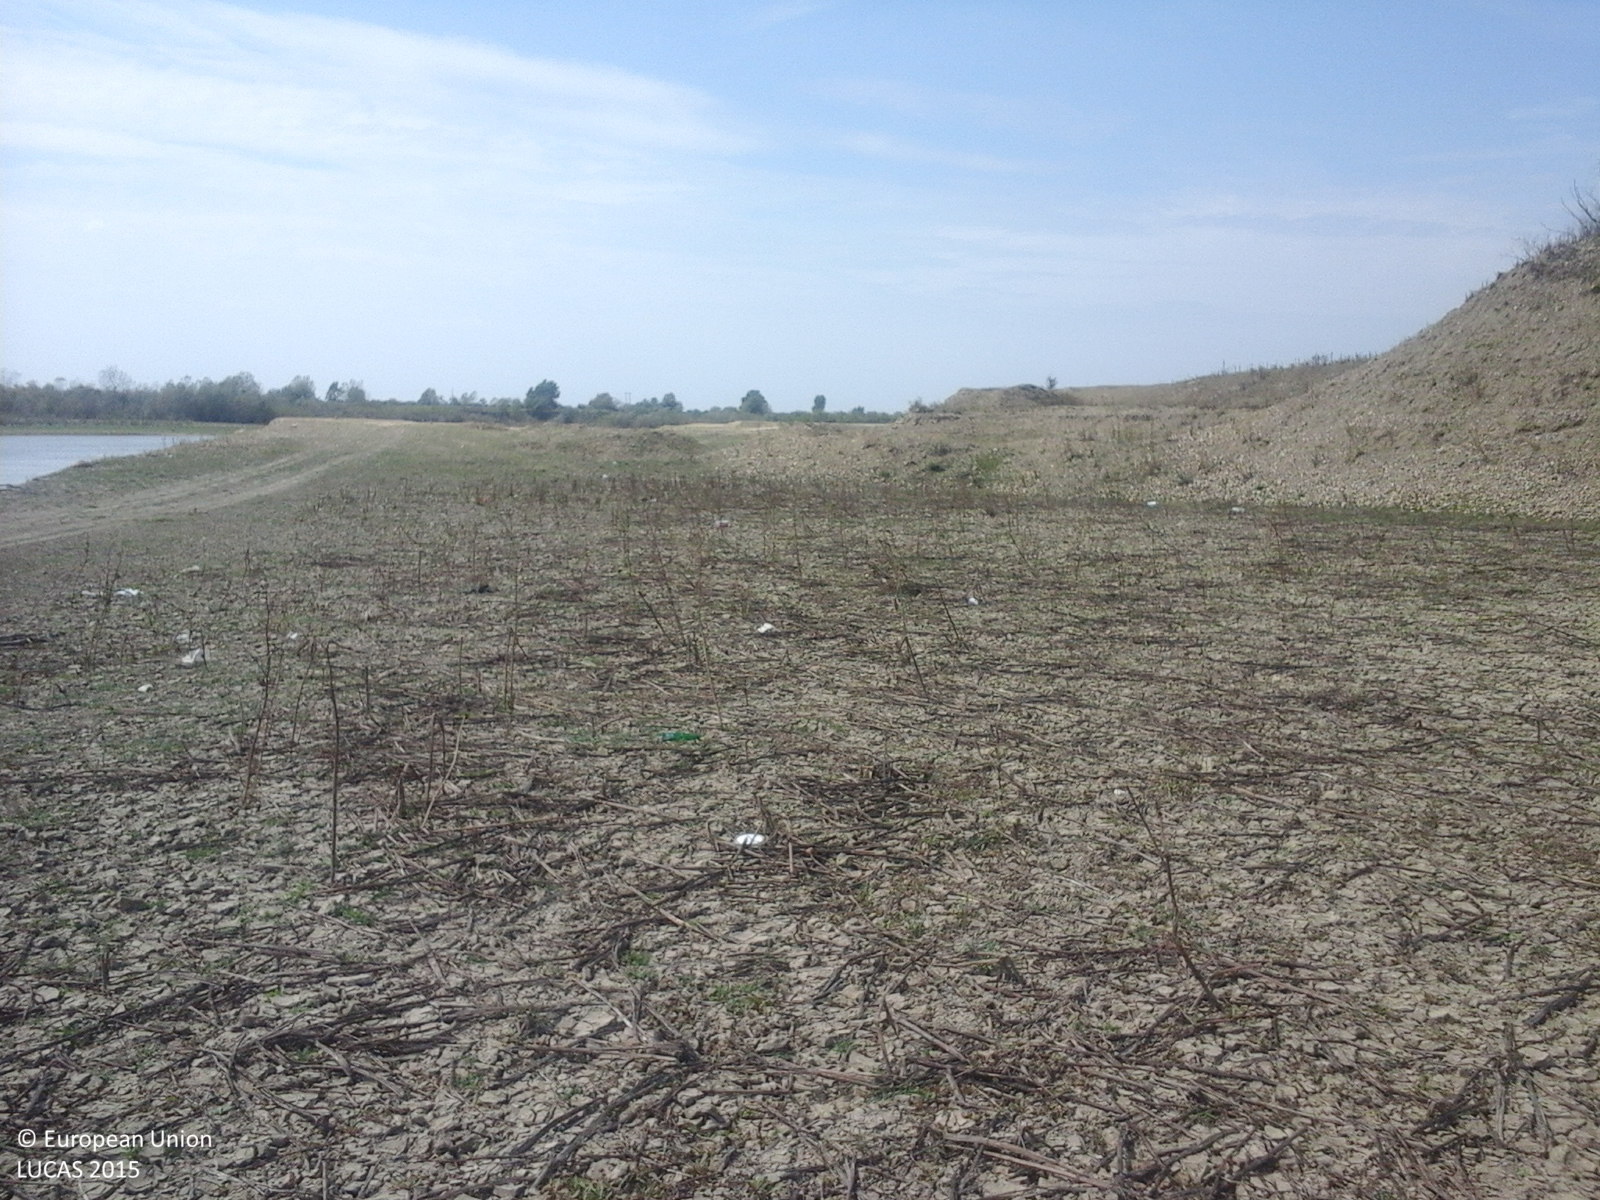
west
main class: Grassland
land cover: Spontaneously vegetated surfaces
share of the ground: > 75 %
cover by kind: herbaceous plants 70 %, consolidated bare surface 30 %
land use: Fallow land
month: August
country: RO
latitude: 46.1271
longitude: 21.5156
